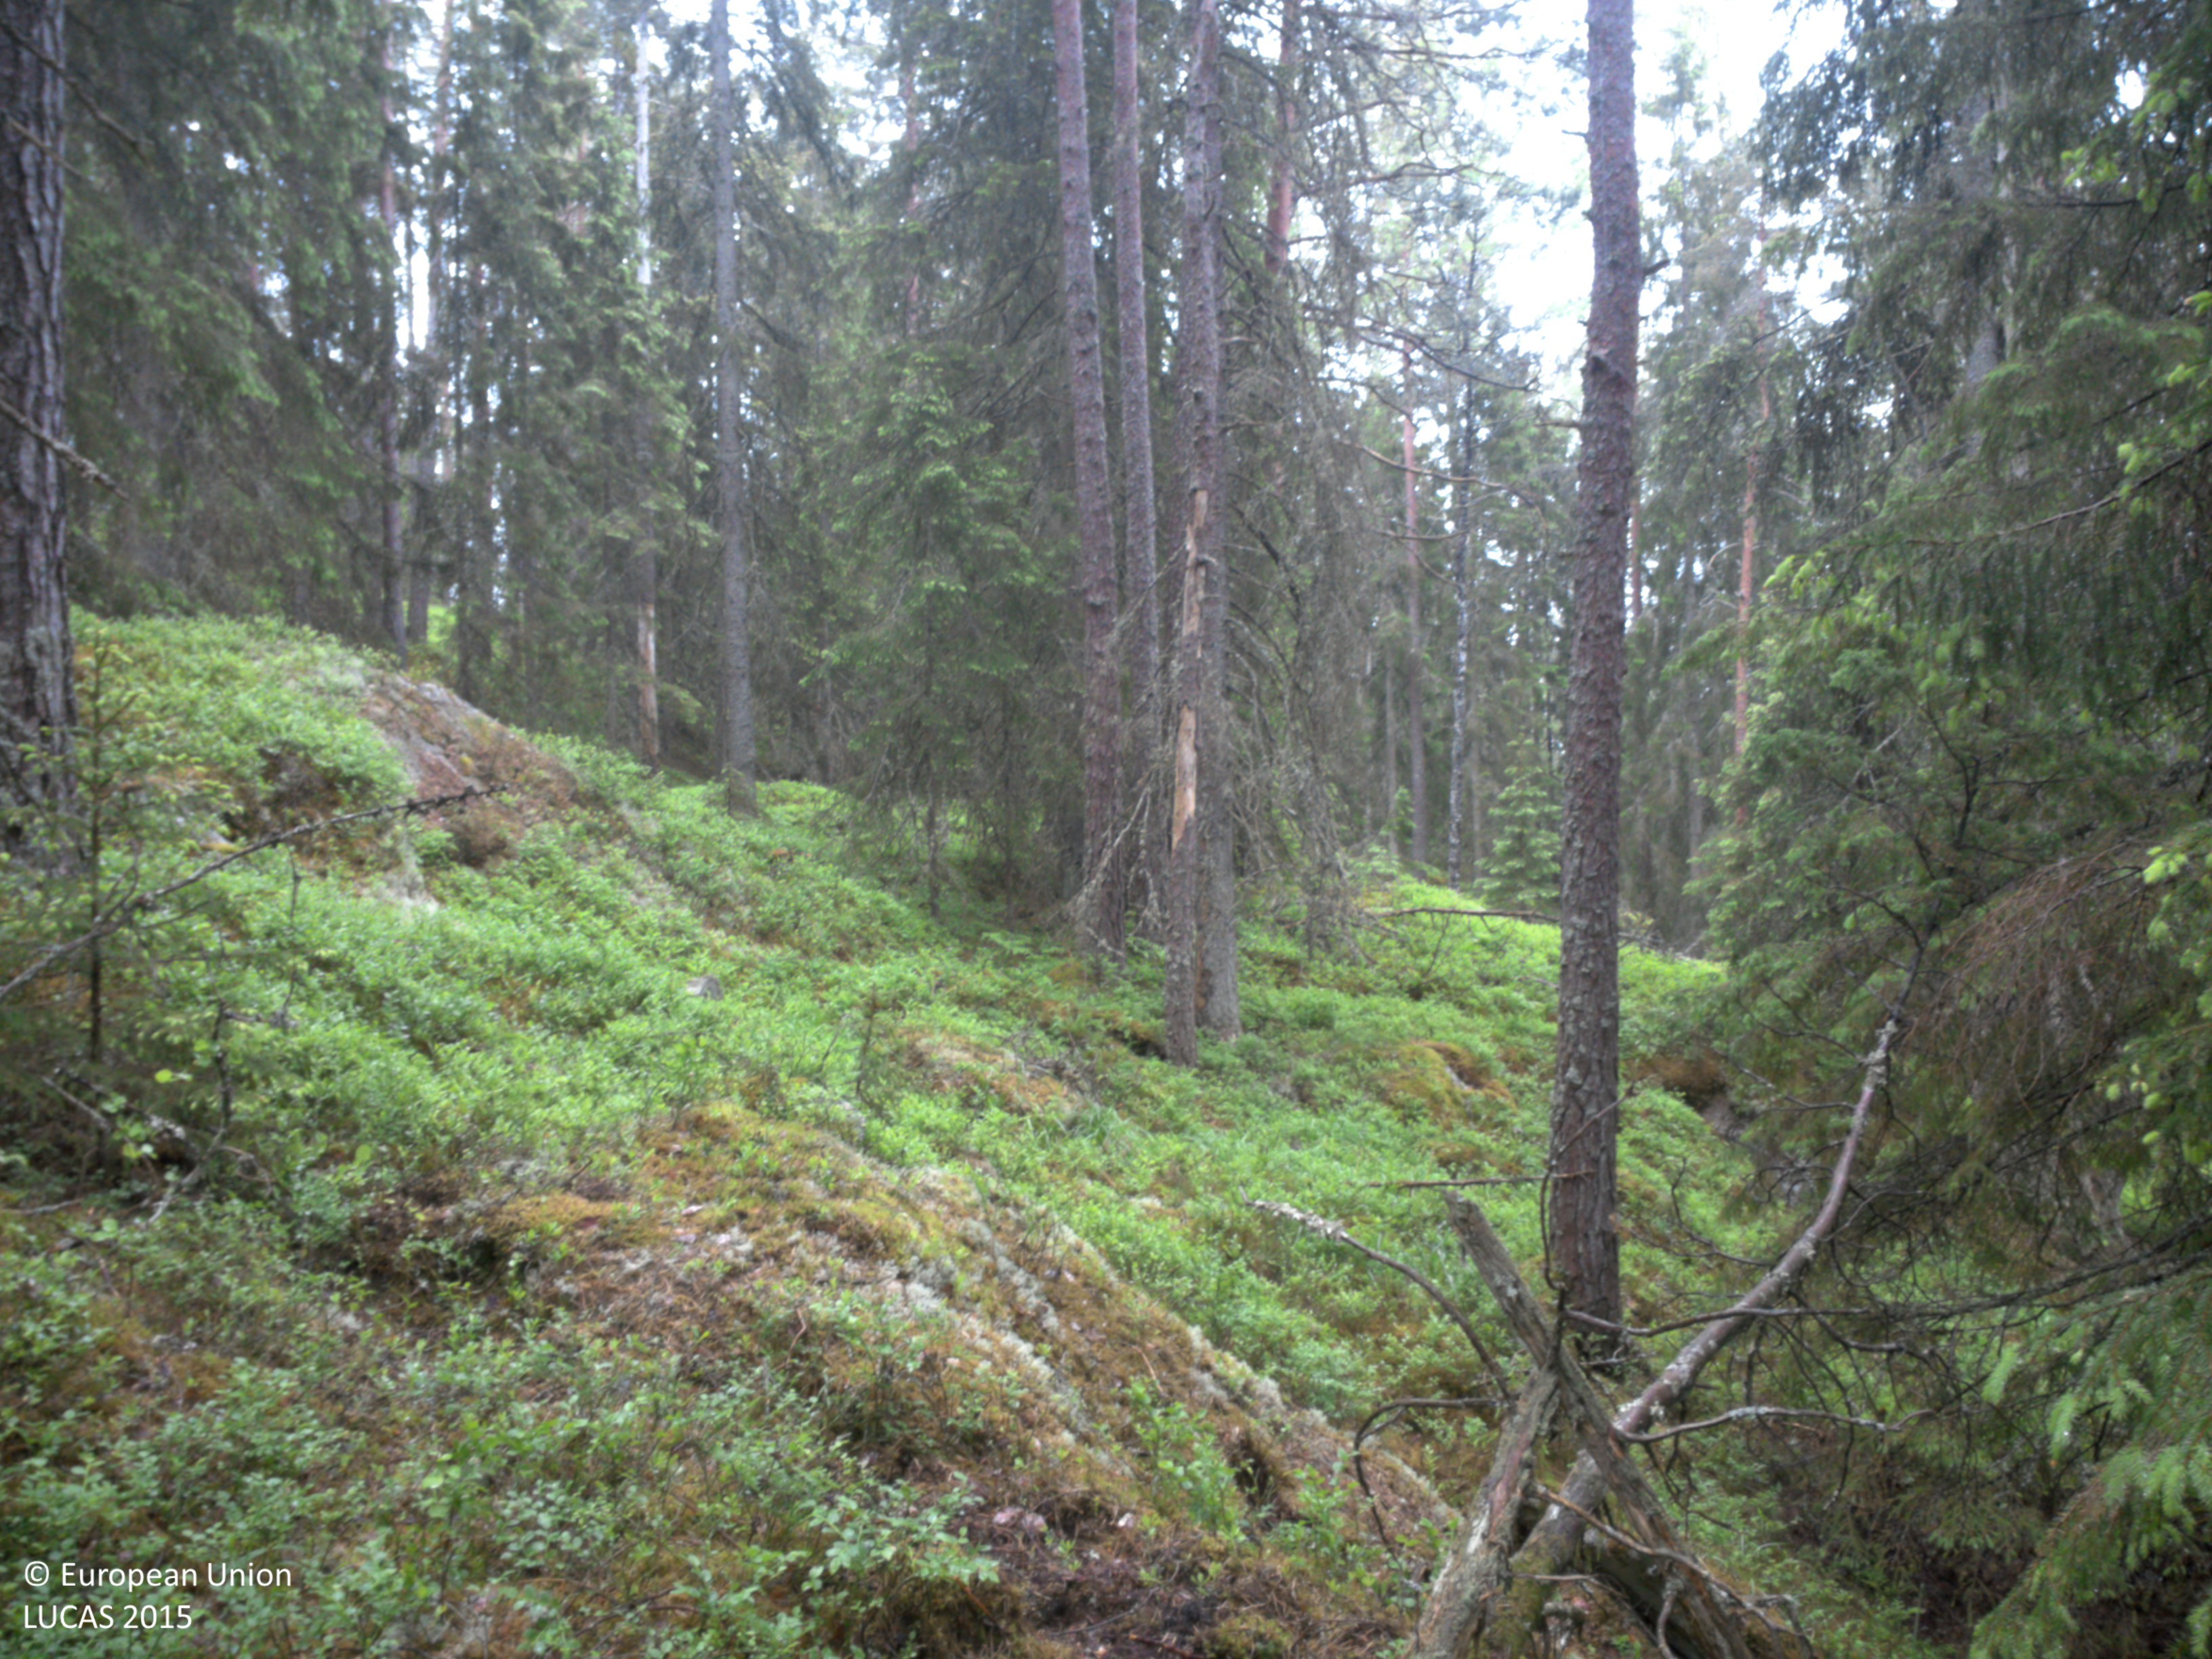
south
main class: Woodland
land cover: Pine dominated coniferous woodland
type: boreal forest
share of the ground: > 75 %
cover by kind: coniferous forest trees 75 %, shrubs 20 %, lichens and mosses 5 %
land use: Forestry
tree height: > 5 m
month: June
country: SE
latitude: 59.0329
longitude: 11.9643
